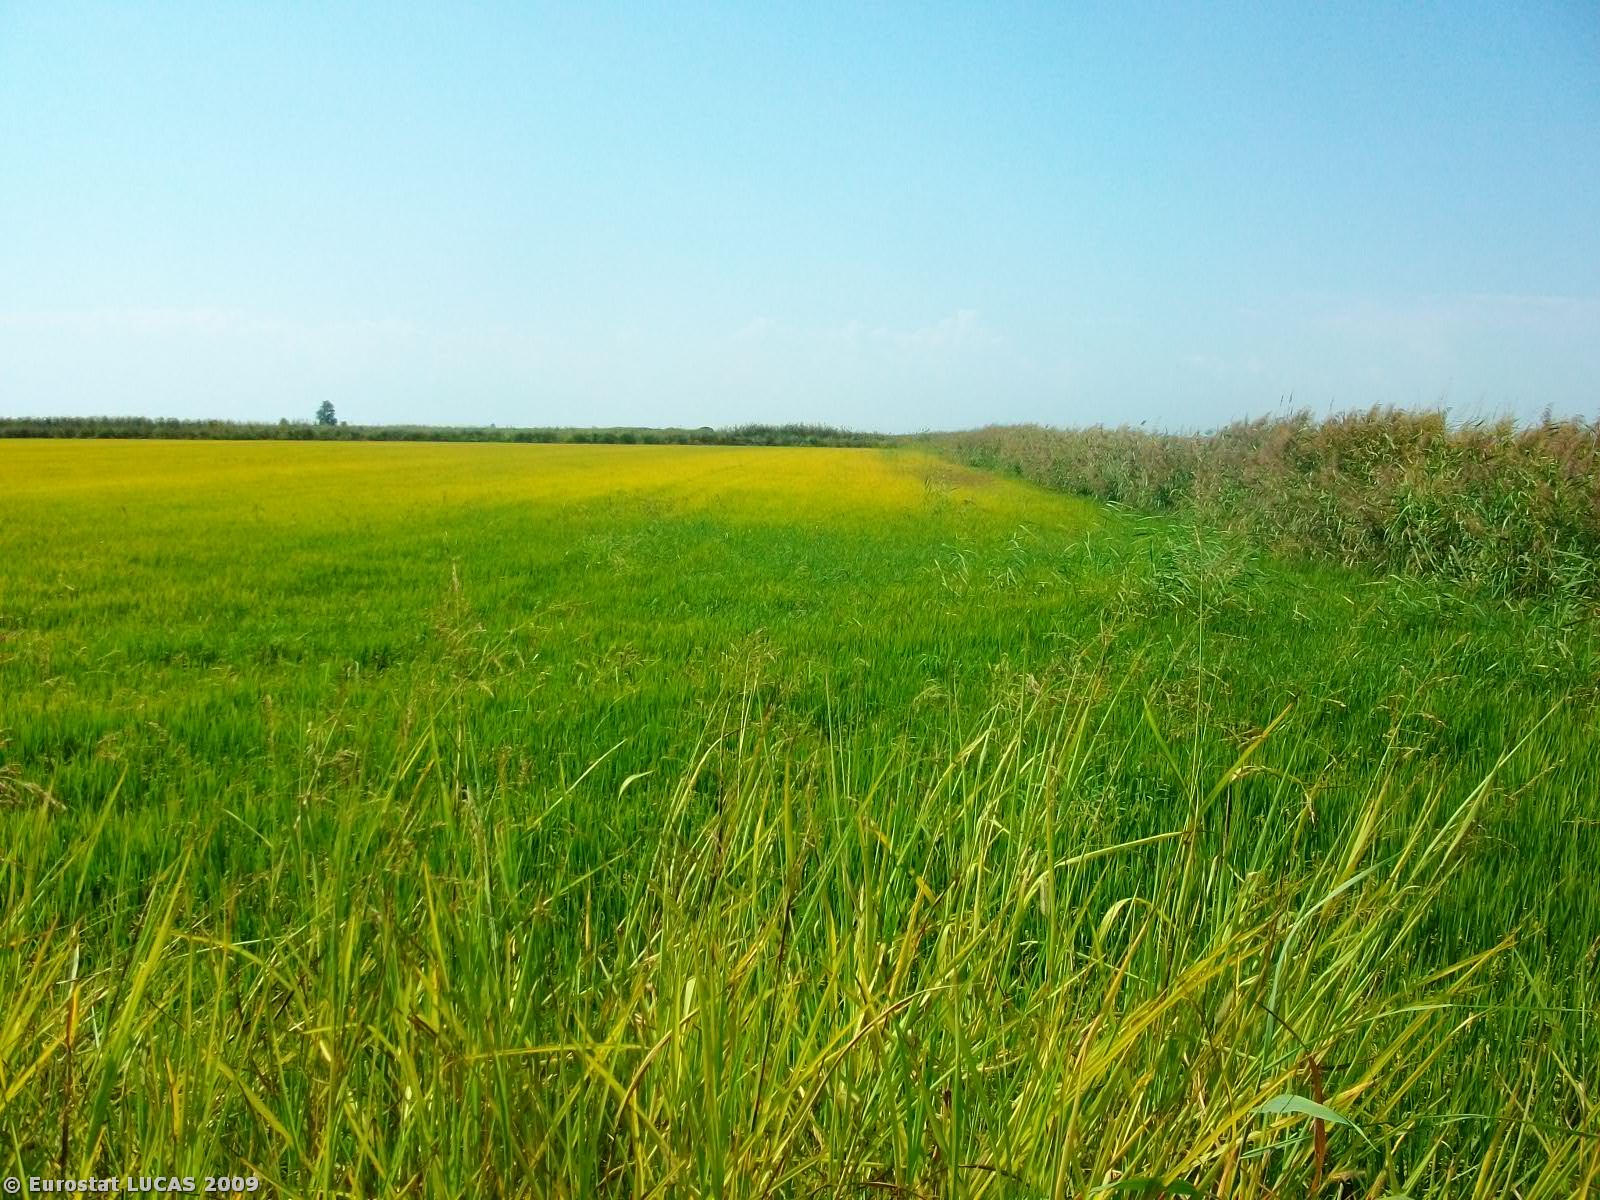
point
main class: Cropland
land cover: Rice
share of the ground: > 75 %
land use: Agriculture (excluding fallow land and kitchen gardens)
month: August
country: GR
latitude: 40.6132
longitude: 22.8060
